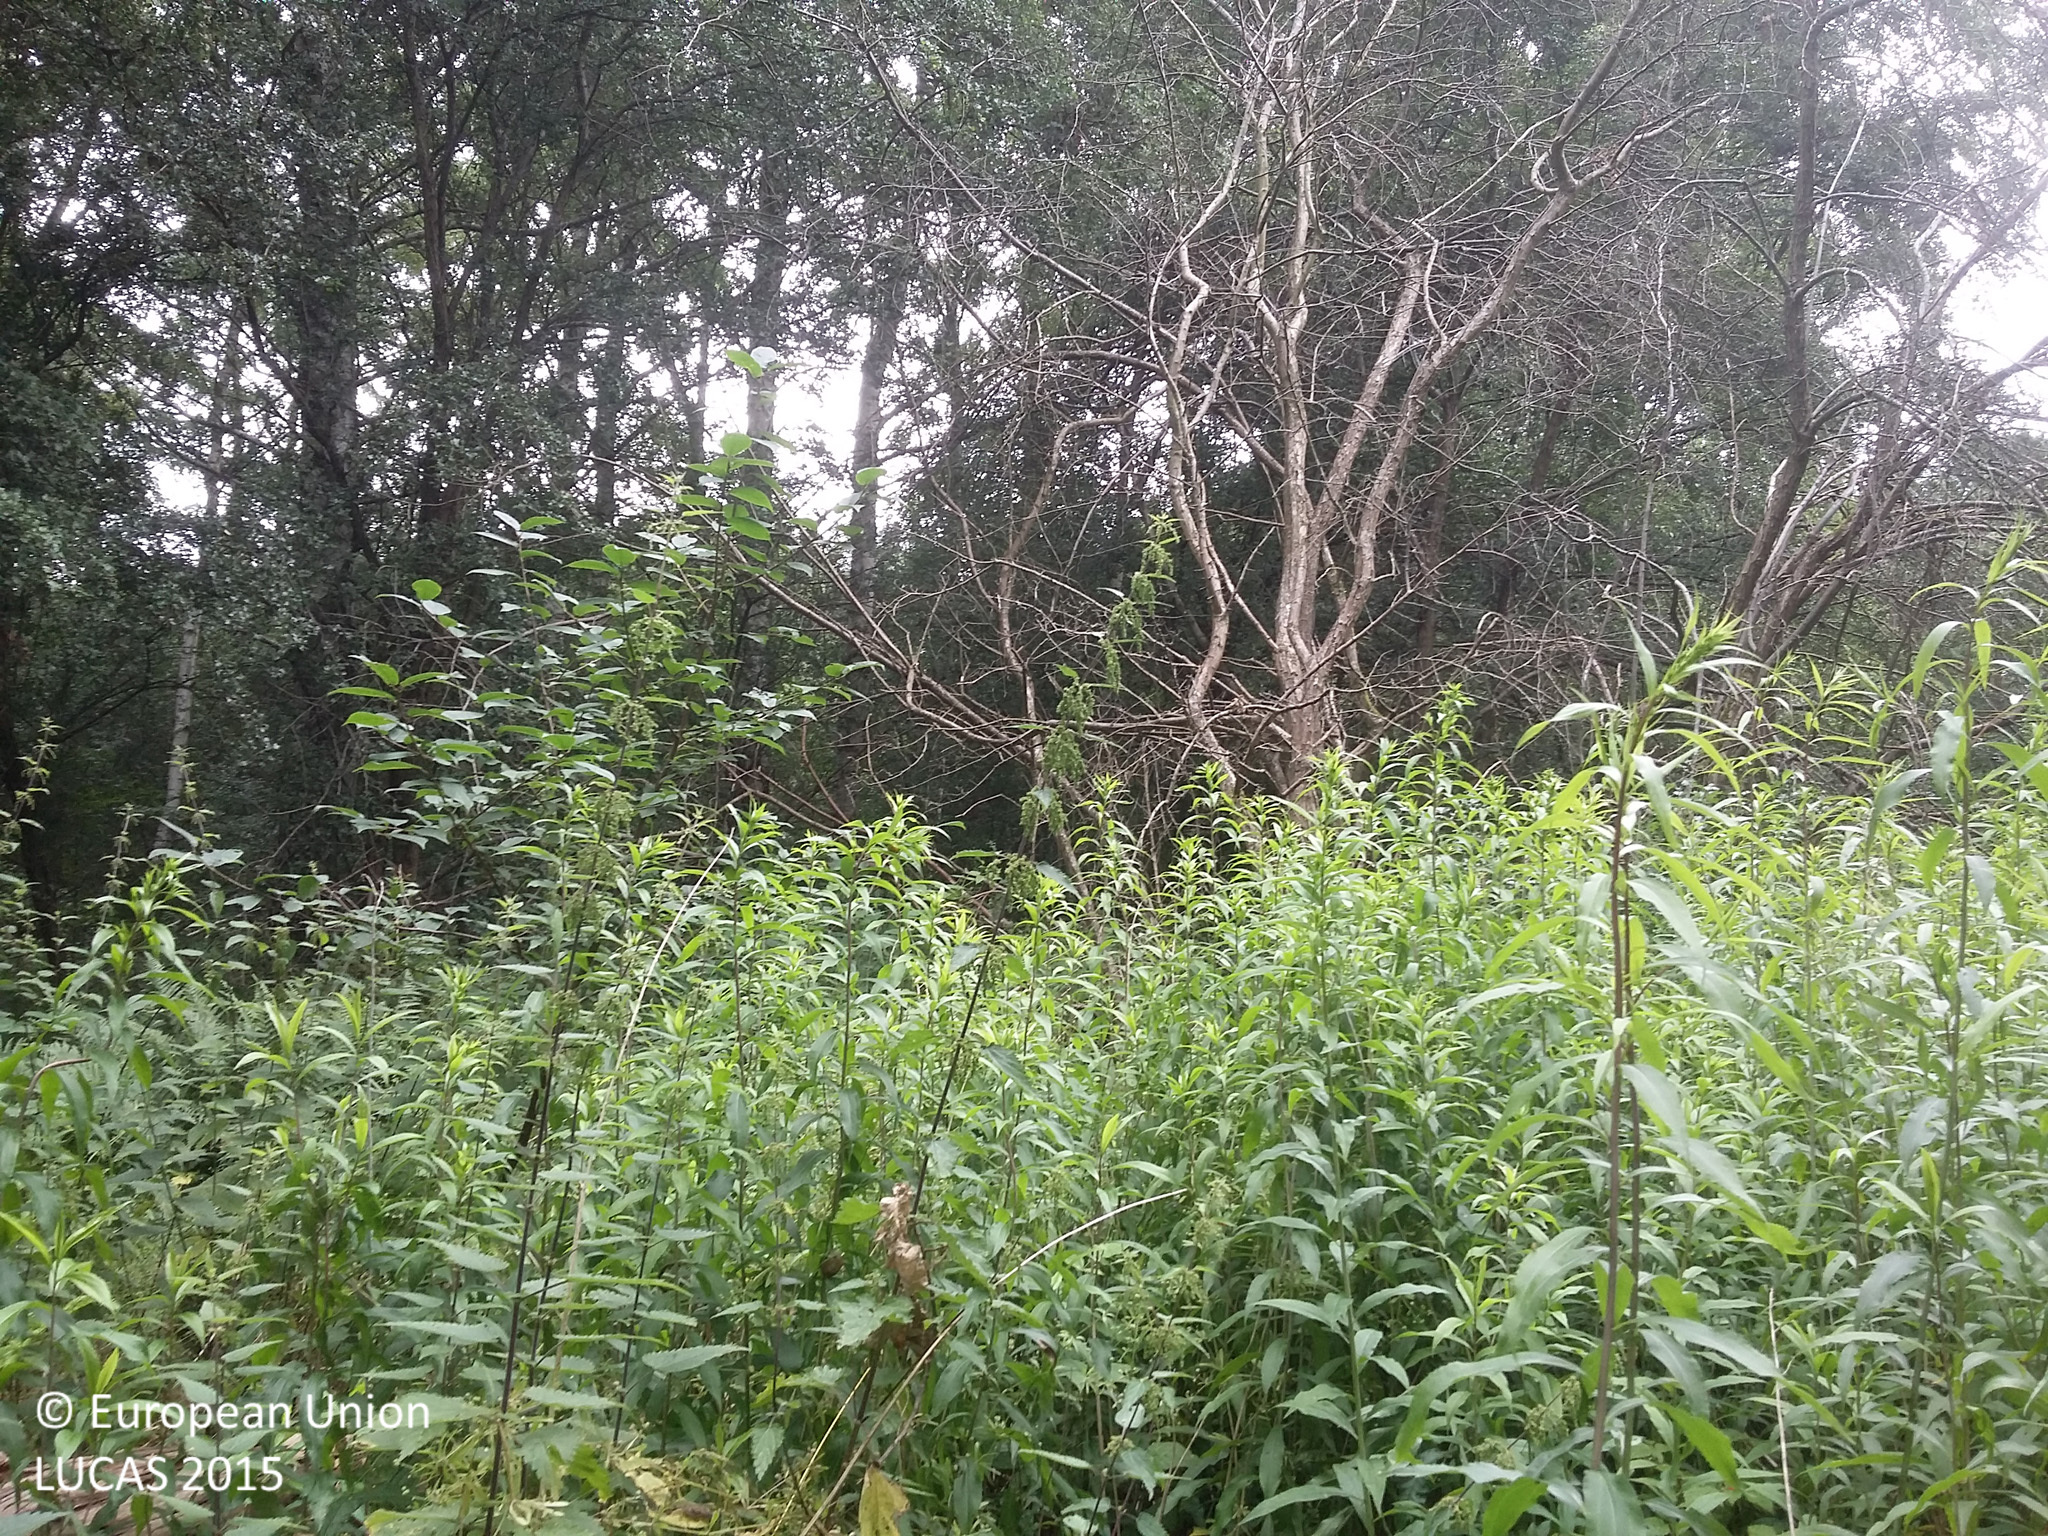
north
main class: Woodland
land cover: Broadleaved woodland
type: thermophilous deciduous forest
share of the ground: 50 - 75 %
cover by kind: herbaceous plants 50 %, broadleaved forest trees 45 %, coniferous forest trees 5 %
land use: Semi-natural and natural areas not in use
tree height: > 5 m
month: July
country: DK
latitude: 55.8031
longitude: 12.5345
